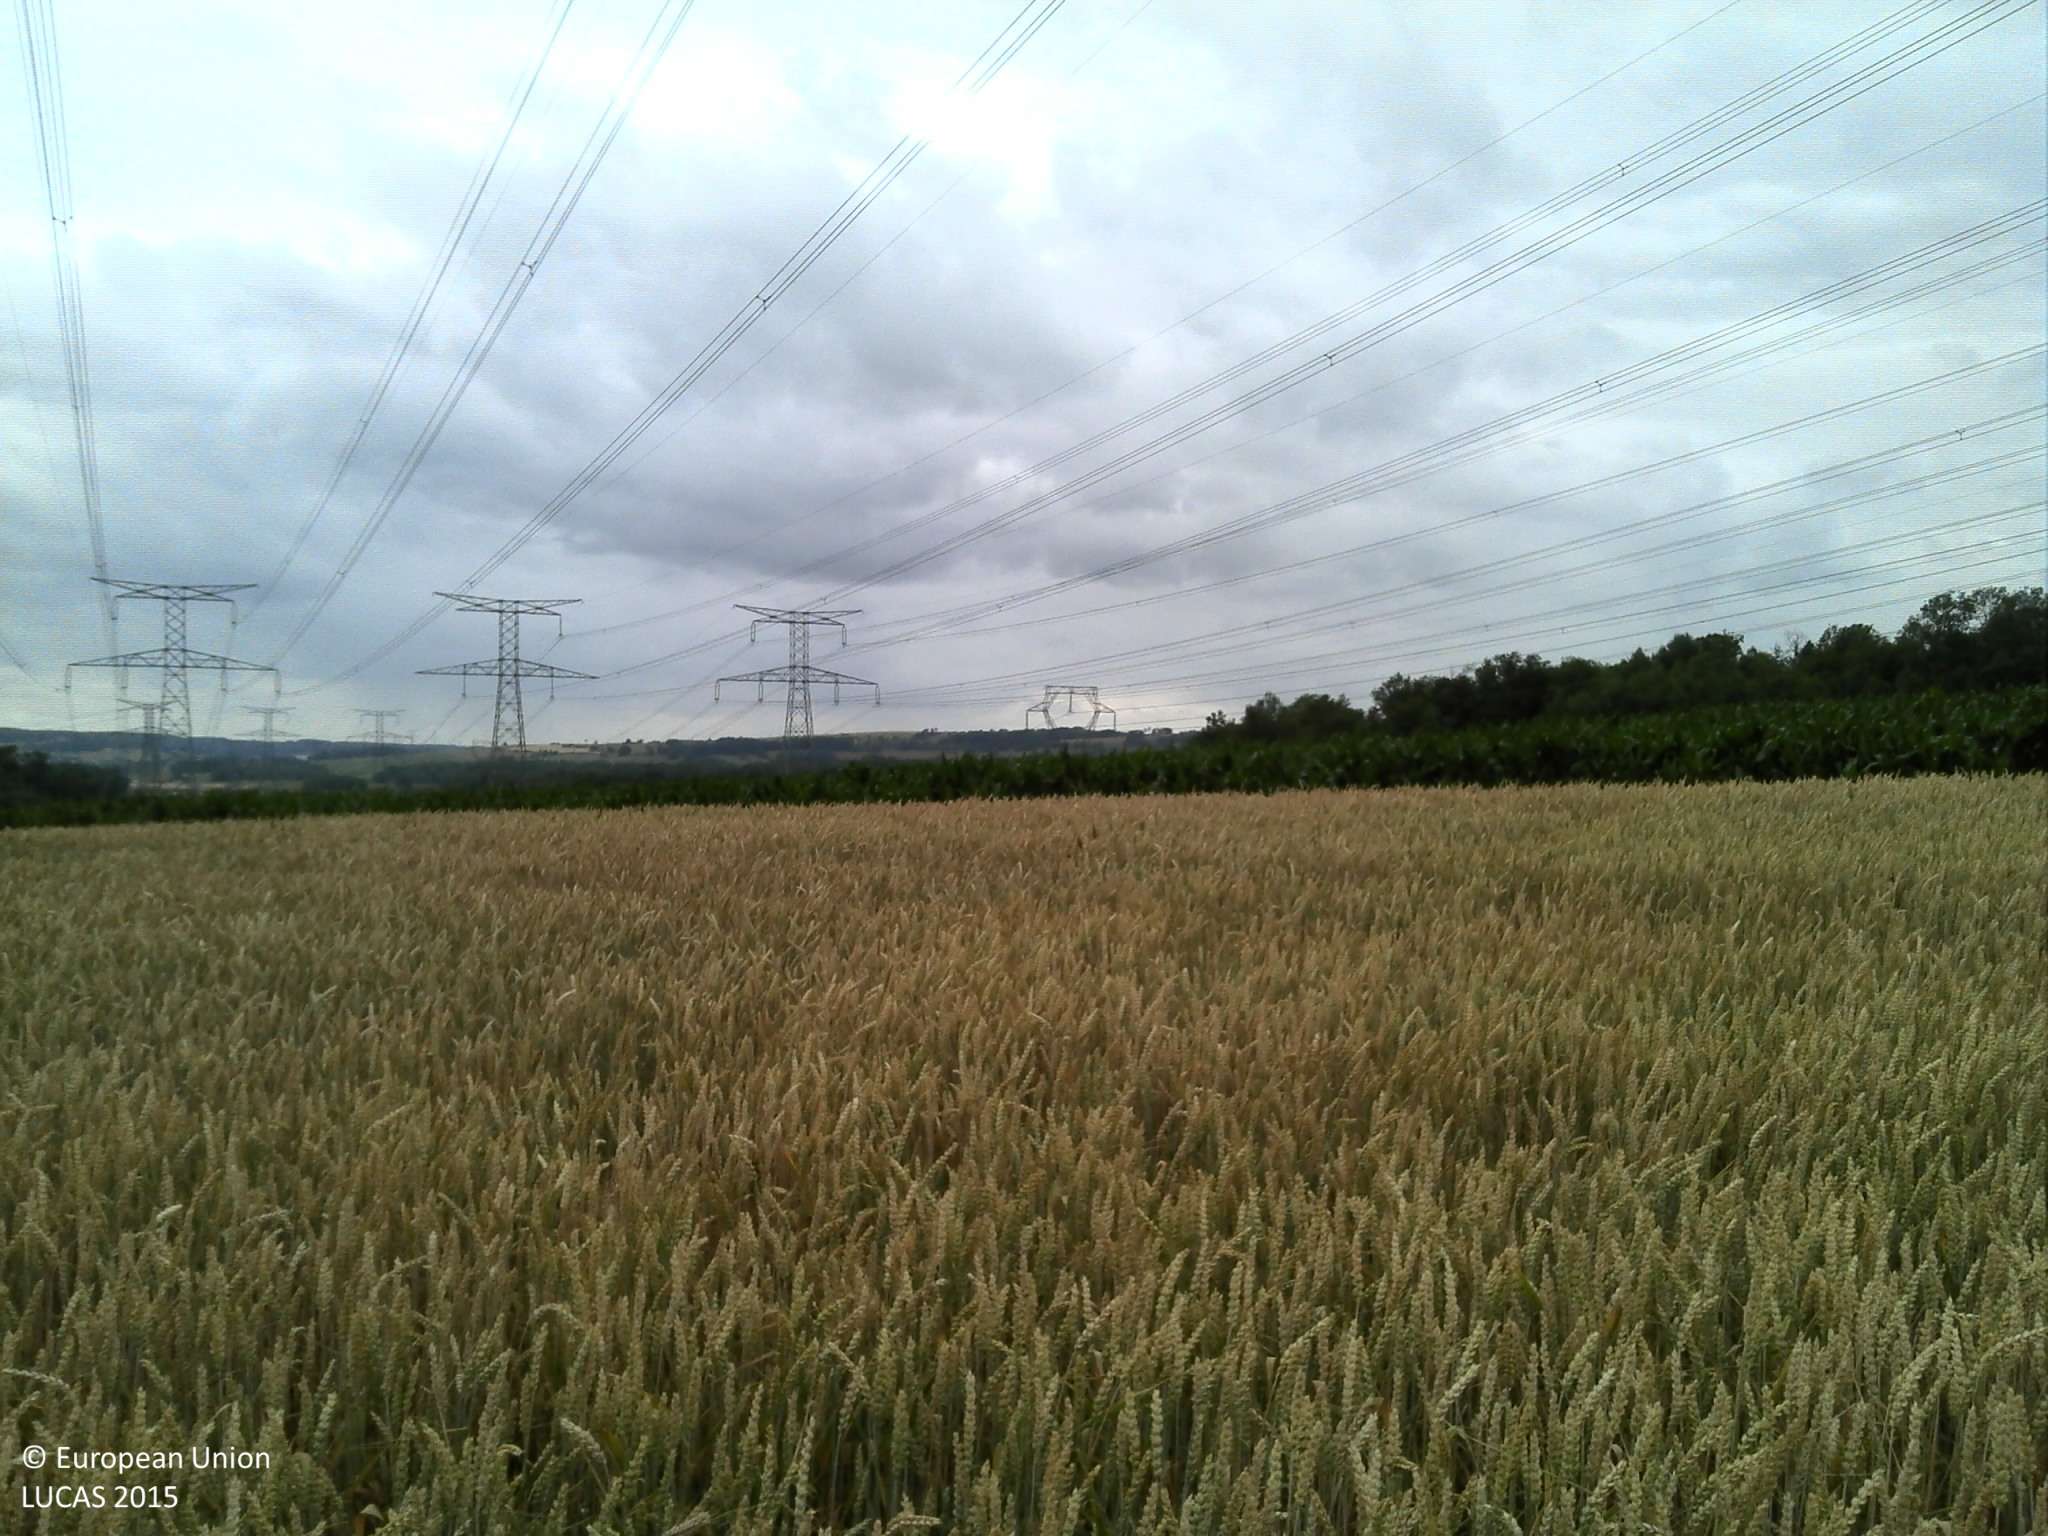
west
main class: Cropland
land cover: Common wheat
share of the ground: > 75 %
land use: Agriculture (excluding fallow land and kitchen gardens)
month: July
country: FR
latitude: 49.8202
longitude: 4.5617
